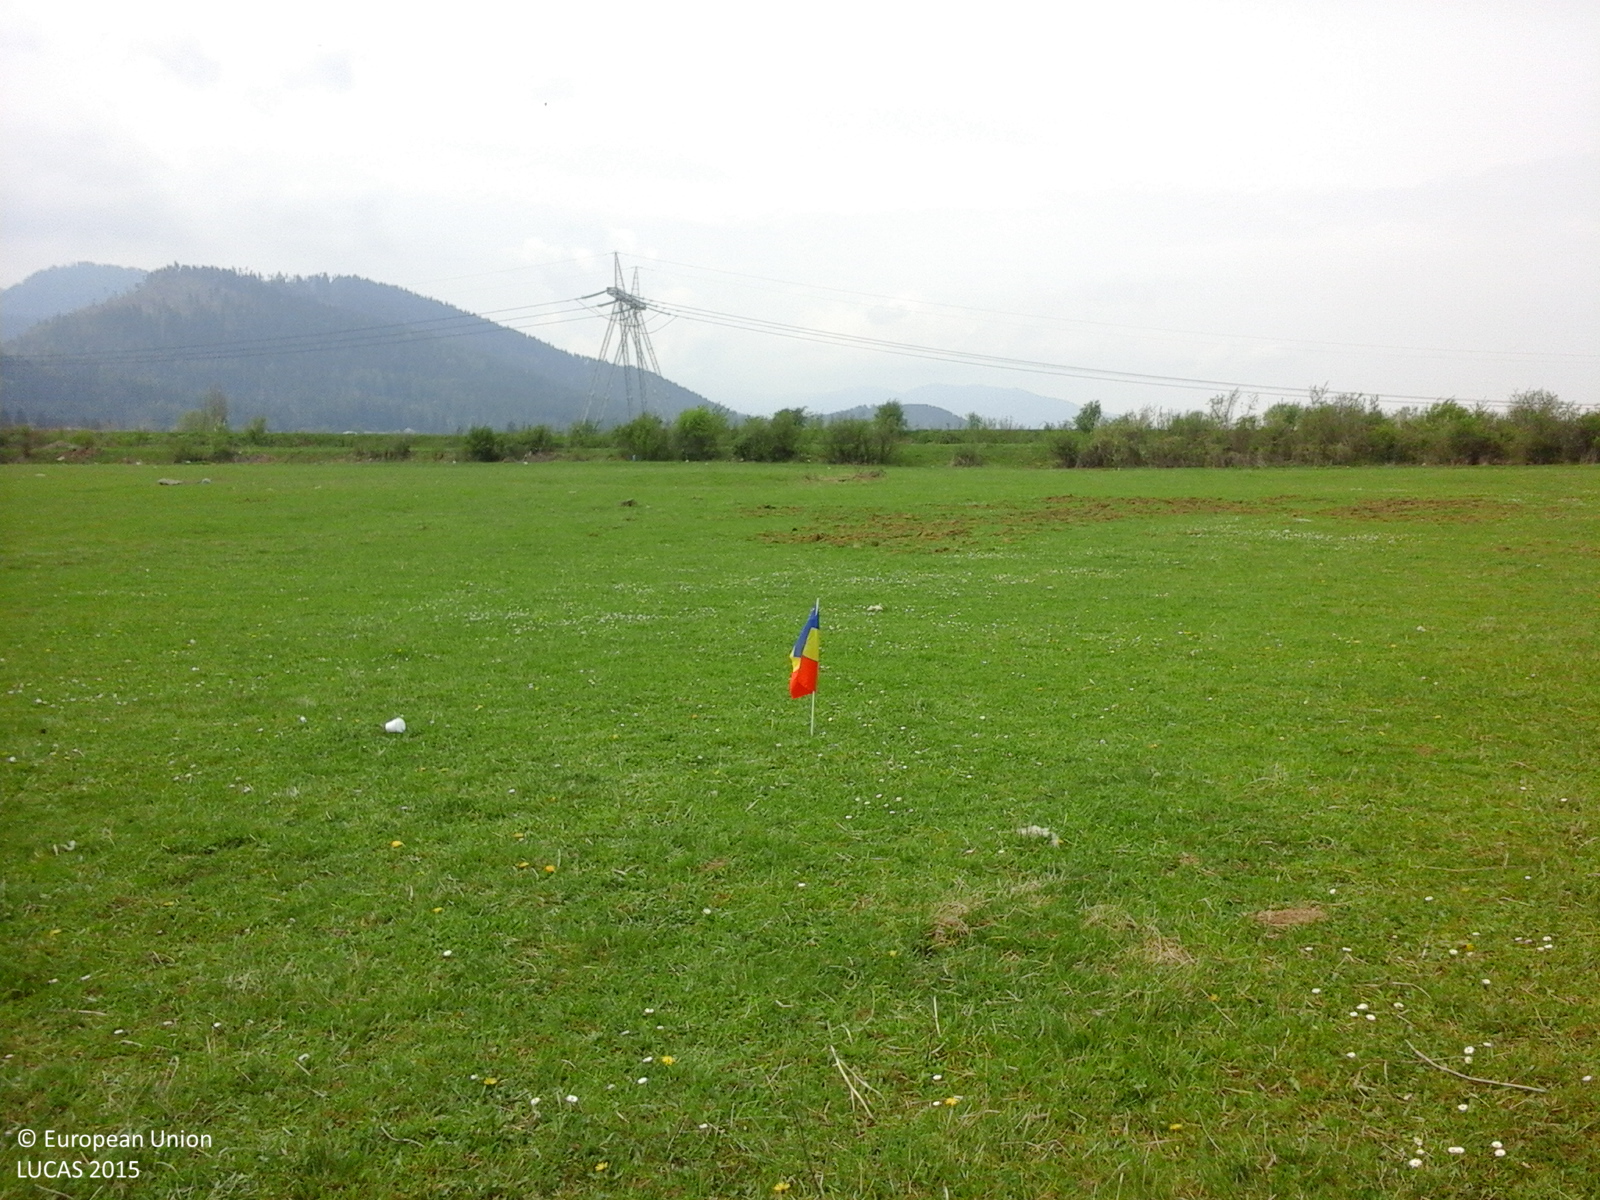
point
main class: Grassland
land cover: Grassland without tree/shrub cover
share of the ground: > 75 %
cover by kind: herbaceous plants 100 %
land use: Agriculture (excluding fallow land and kitchen gardens)
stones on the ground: < 10 %
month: May
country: RO
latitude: 45.6167
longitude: 25.7402
